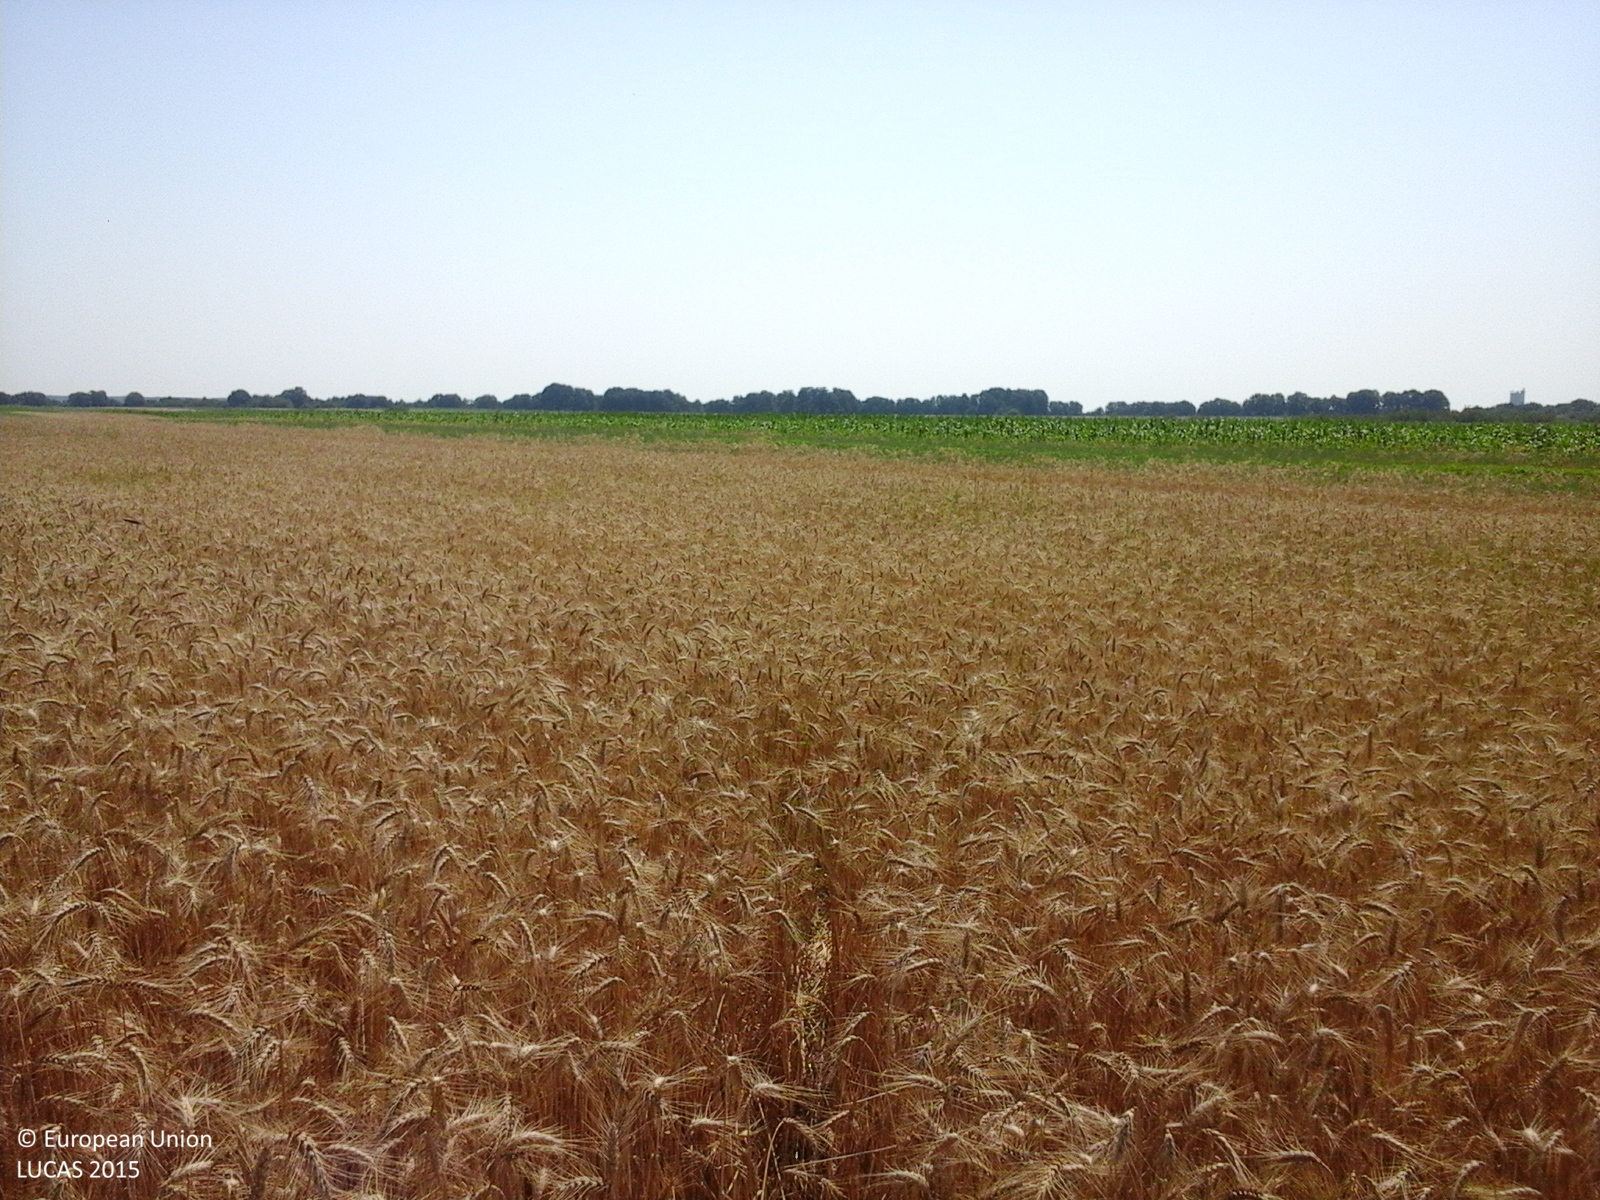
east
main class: Cropland
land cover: Common wheat
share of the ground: > 75 %
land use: Agriculture (excluding fallow land and kitchen gardens)
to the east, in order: Common wheat; Barley; Maize
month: July
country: RO
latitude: 44.6845
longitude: 24.8540
